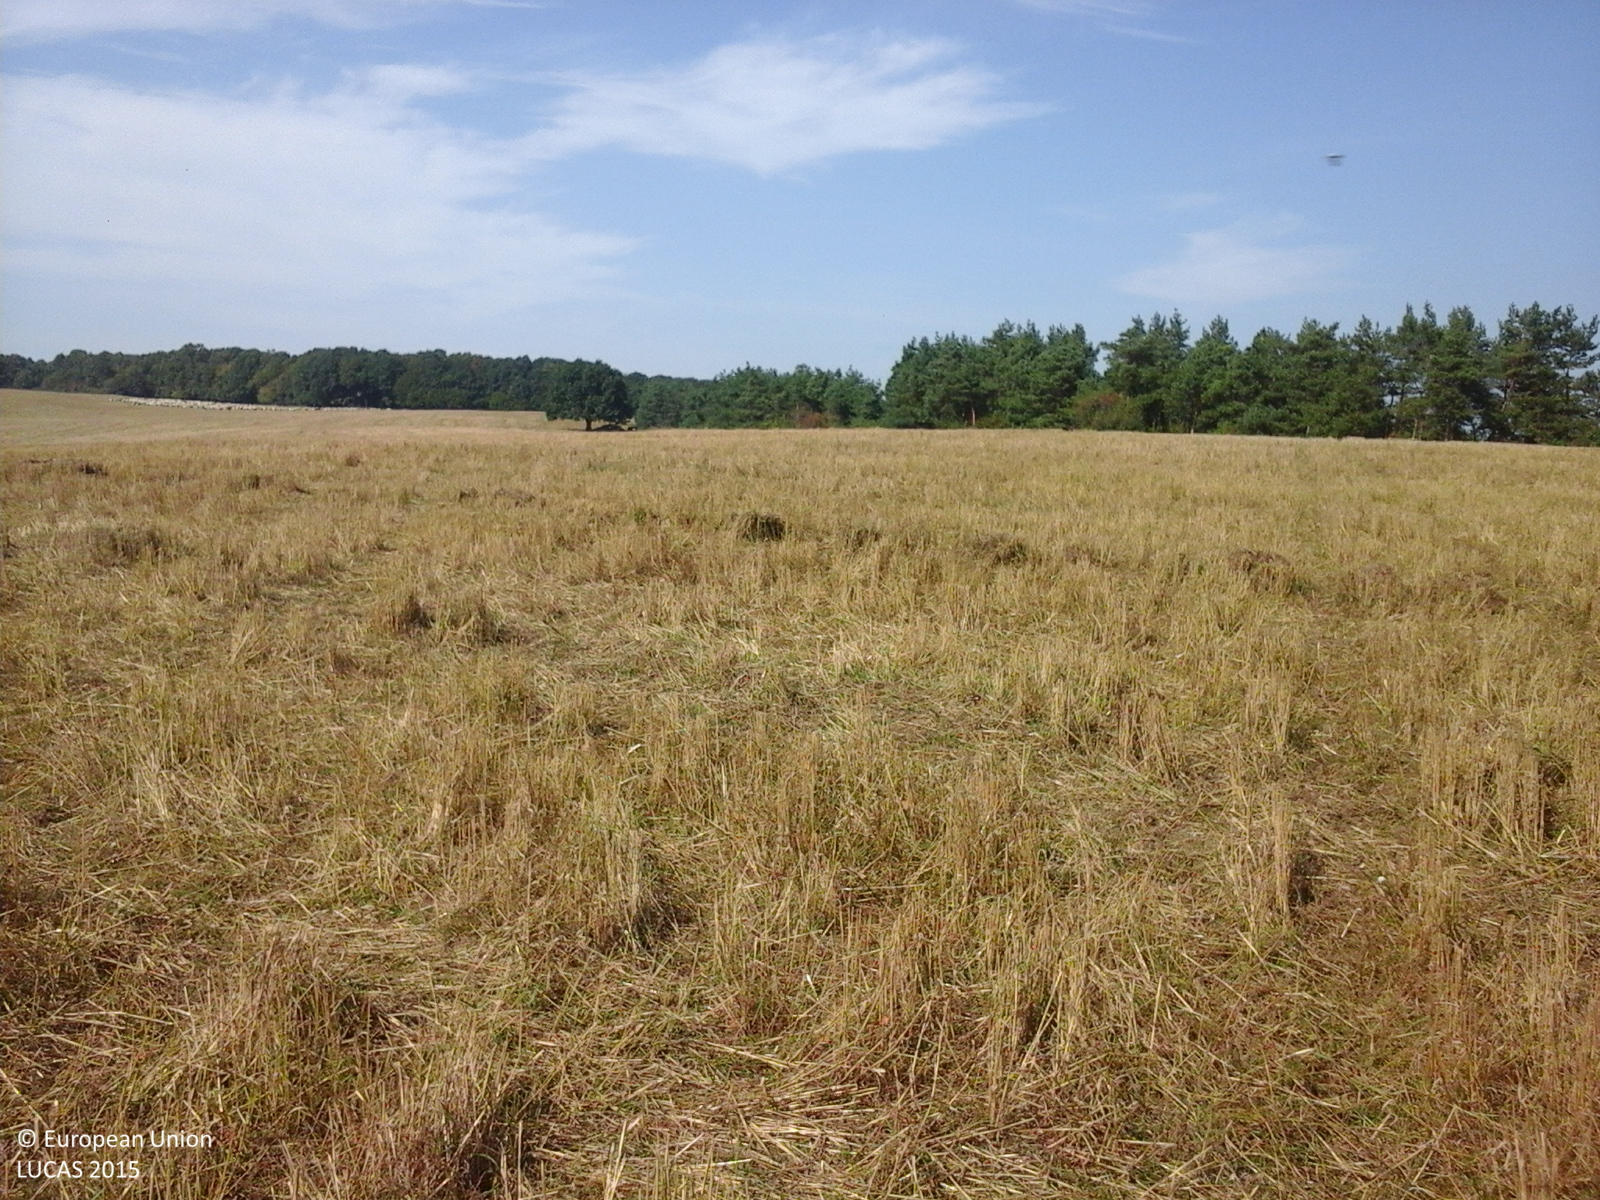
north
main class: Cropland
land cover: Common wheat
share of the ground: > 75 %
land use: Agriculture (excluding fallow land and kitchen gardens)
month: September
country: RO
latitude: 47.1203
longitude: 23.7444
